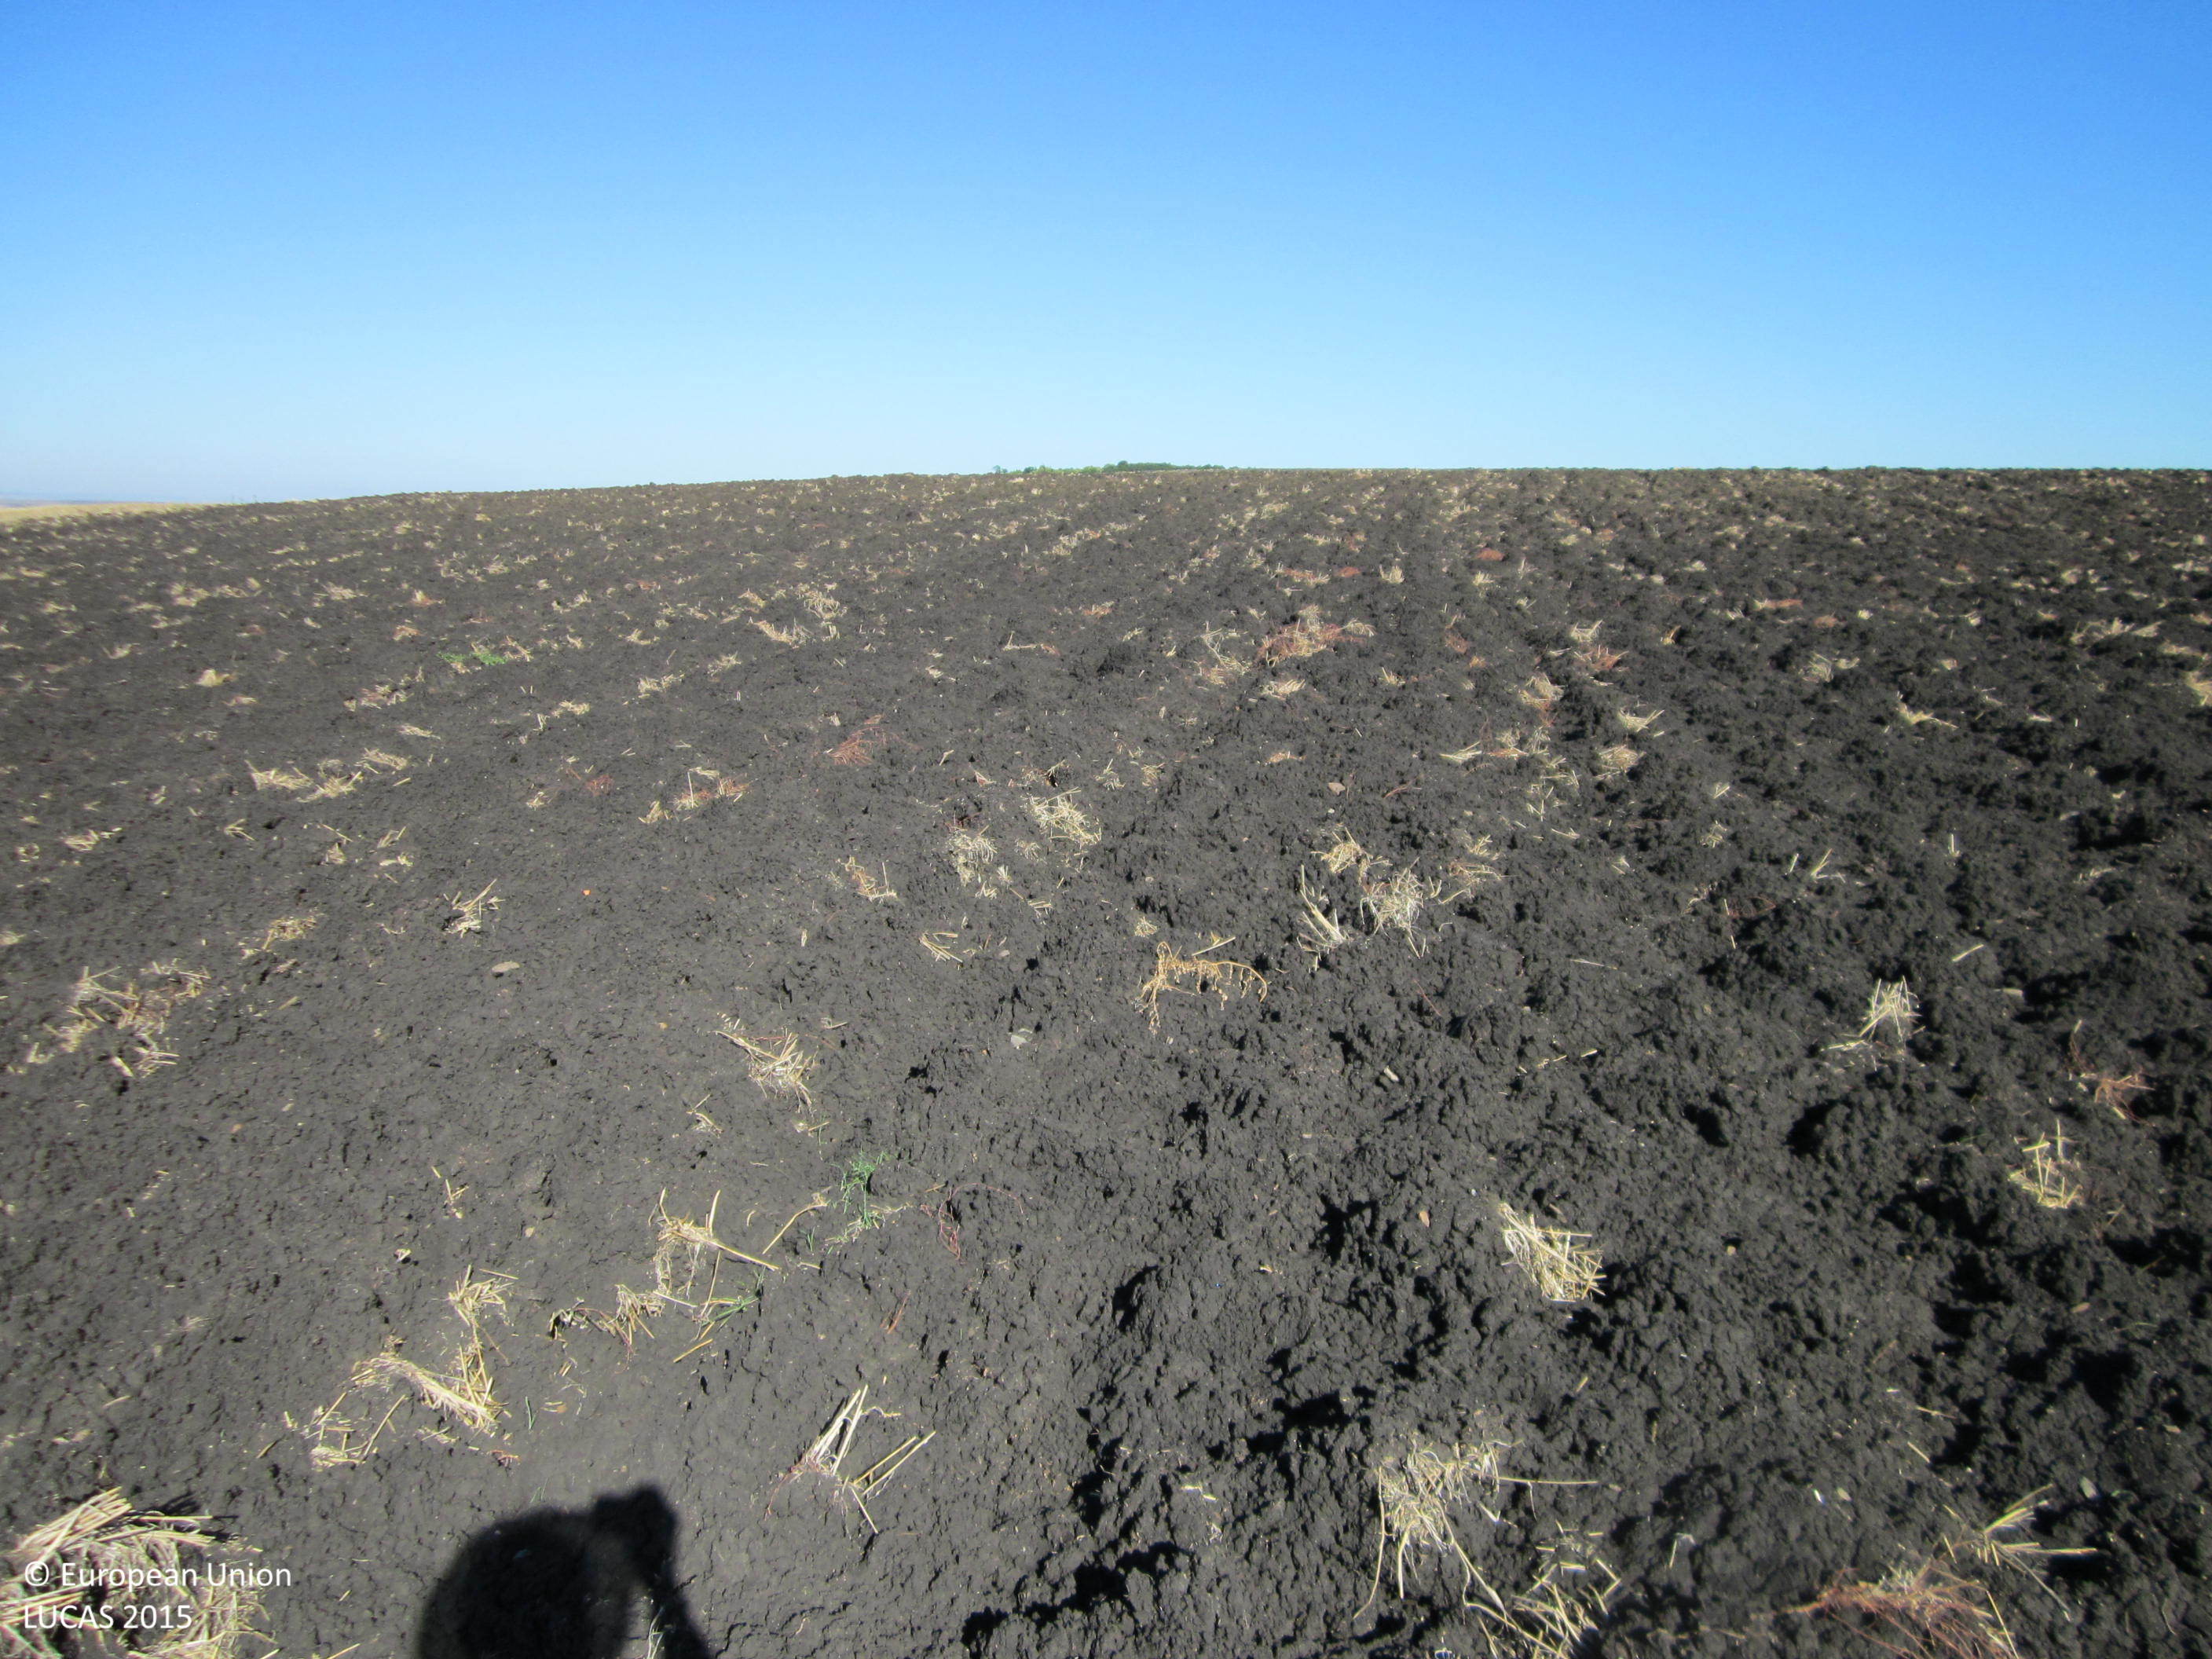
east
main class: Cropland
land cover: Common wheat
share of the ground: < 10 %
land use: Agriculture (excluding fallow land and kitchen gardens)
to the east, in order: Common wheat; Grass margins; Ditches and canals; Grass margins; Common wheat
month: September
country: BG
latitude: 42.4629
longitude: 27.0710
